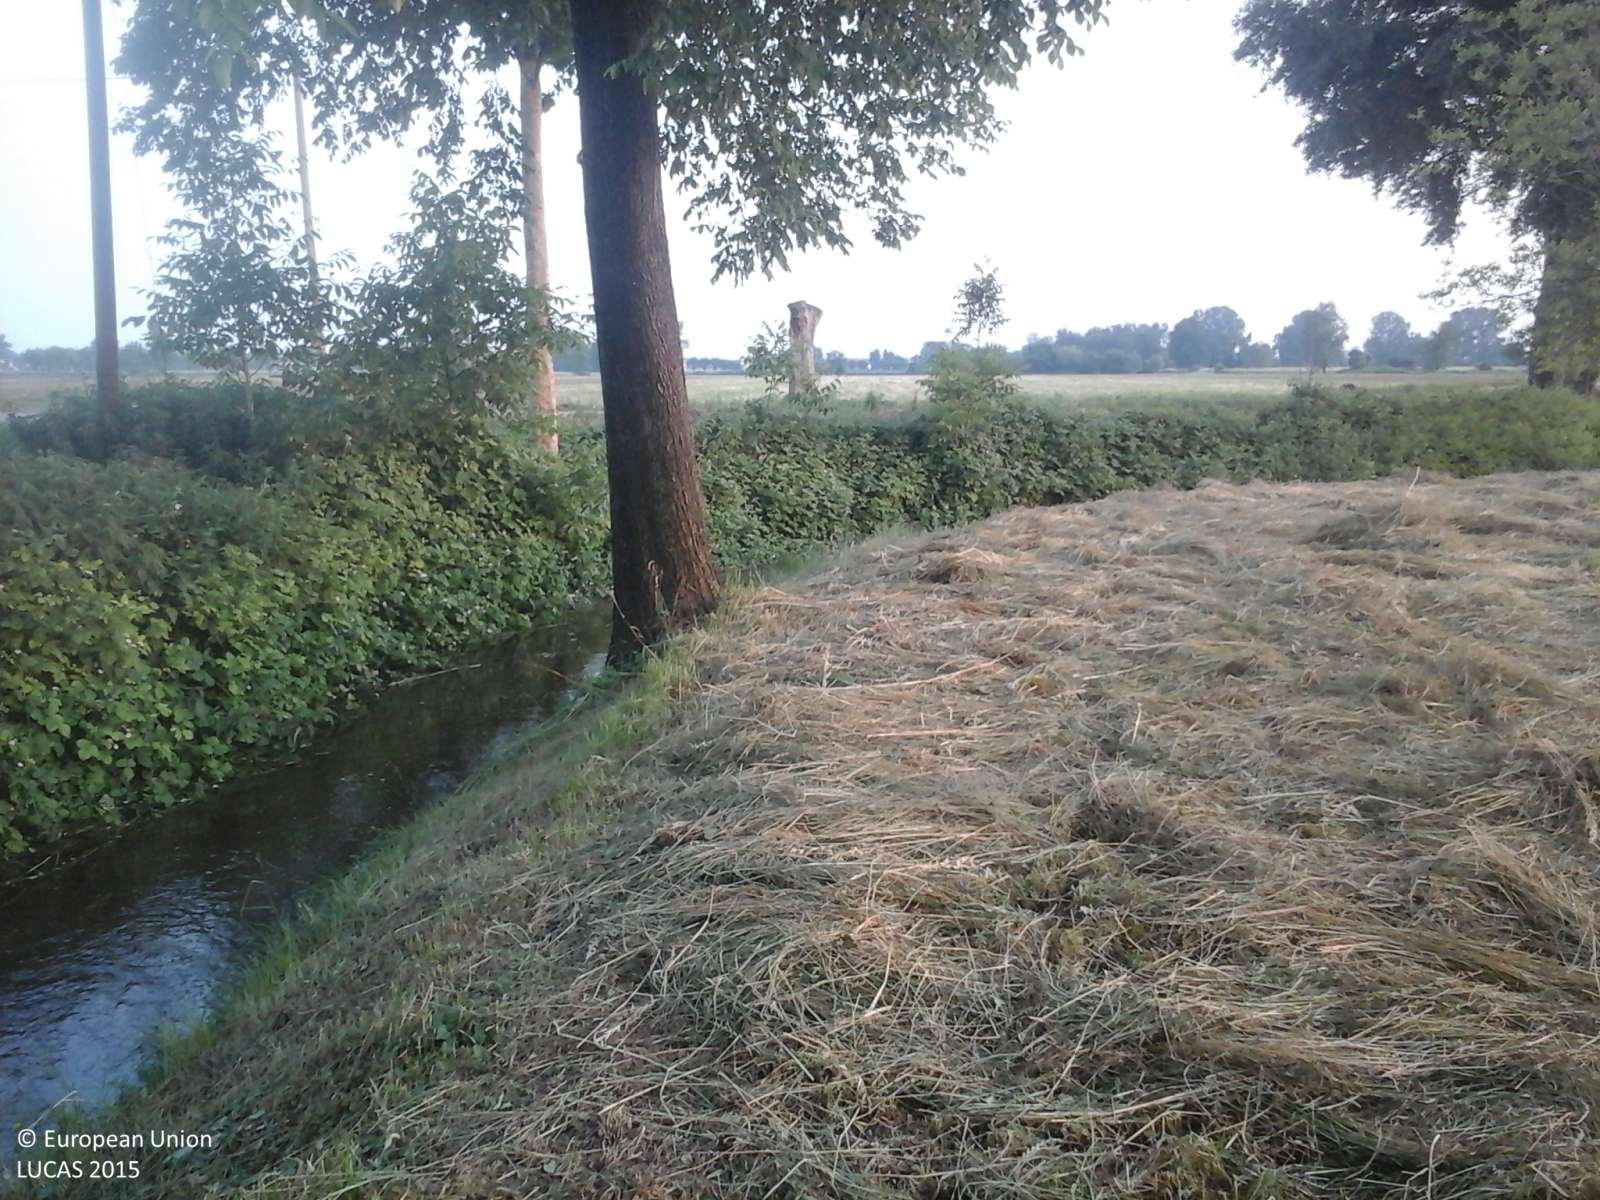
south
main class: Grassland
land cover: Grassland without tree/shrub cover
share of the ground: > 75 %
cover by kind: herbaceous plants 100 %
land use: Agriculture (excluding fallow land and kitchen gardens)
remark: Harvested field
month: May
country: IT
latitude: 45.3595
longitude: 10.3950
